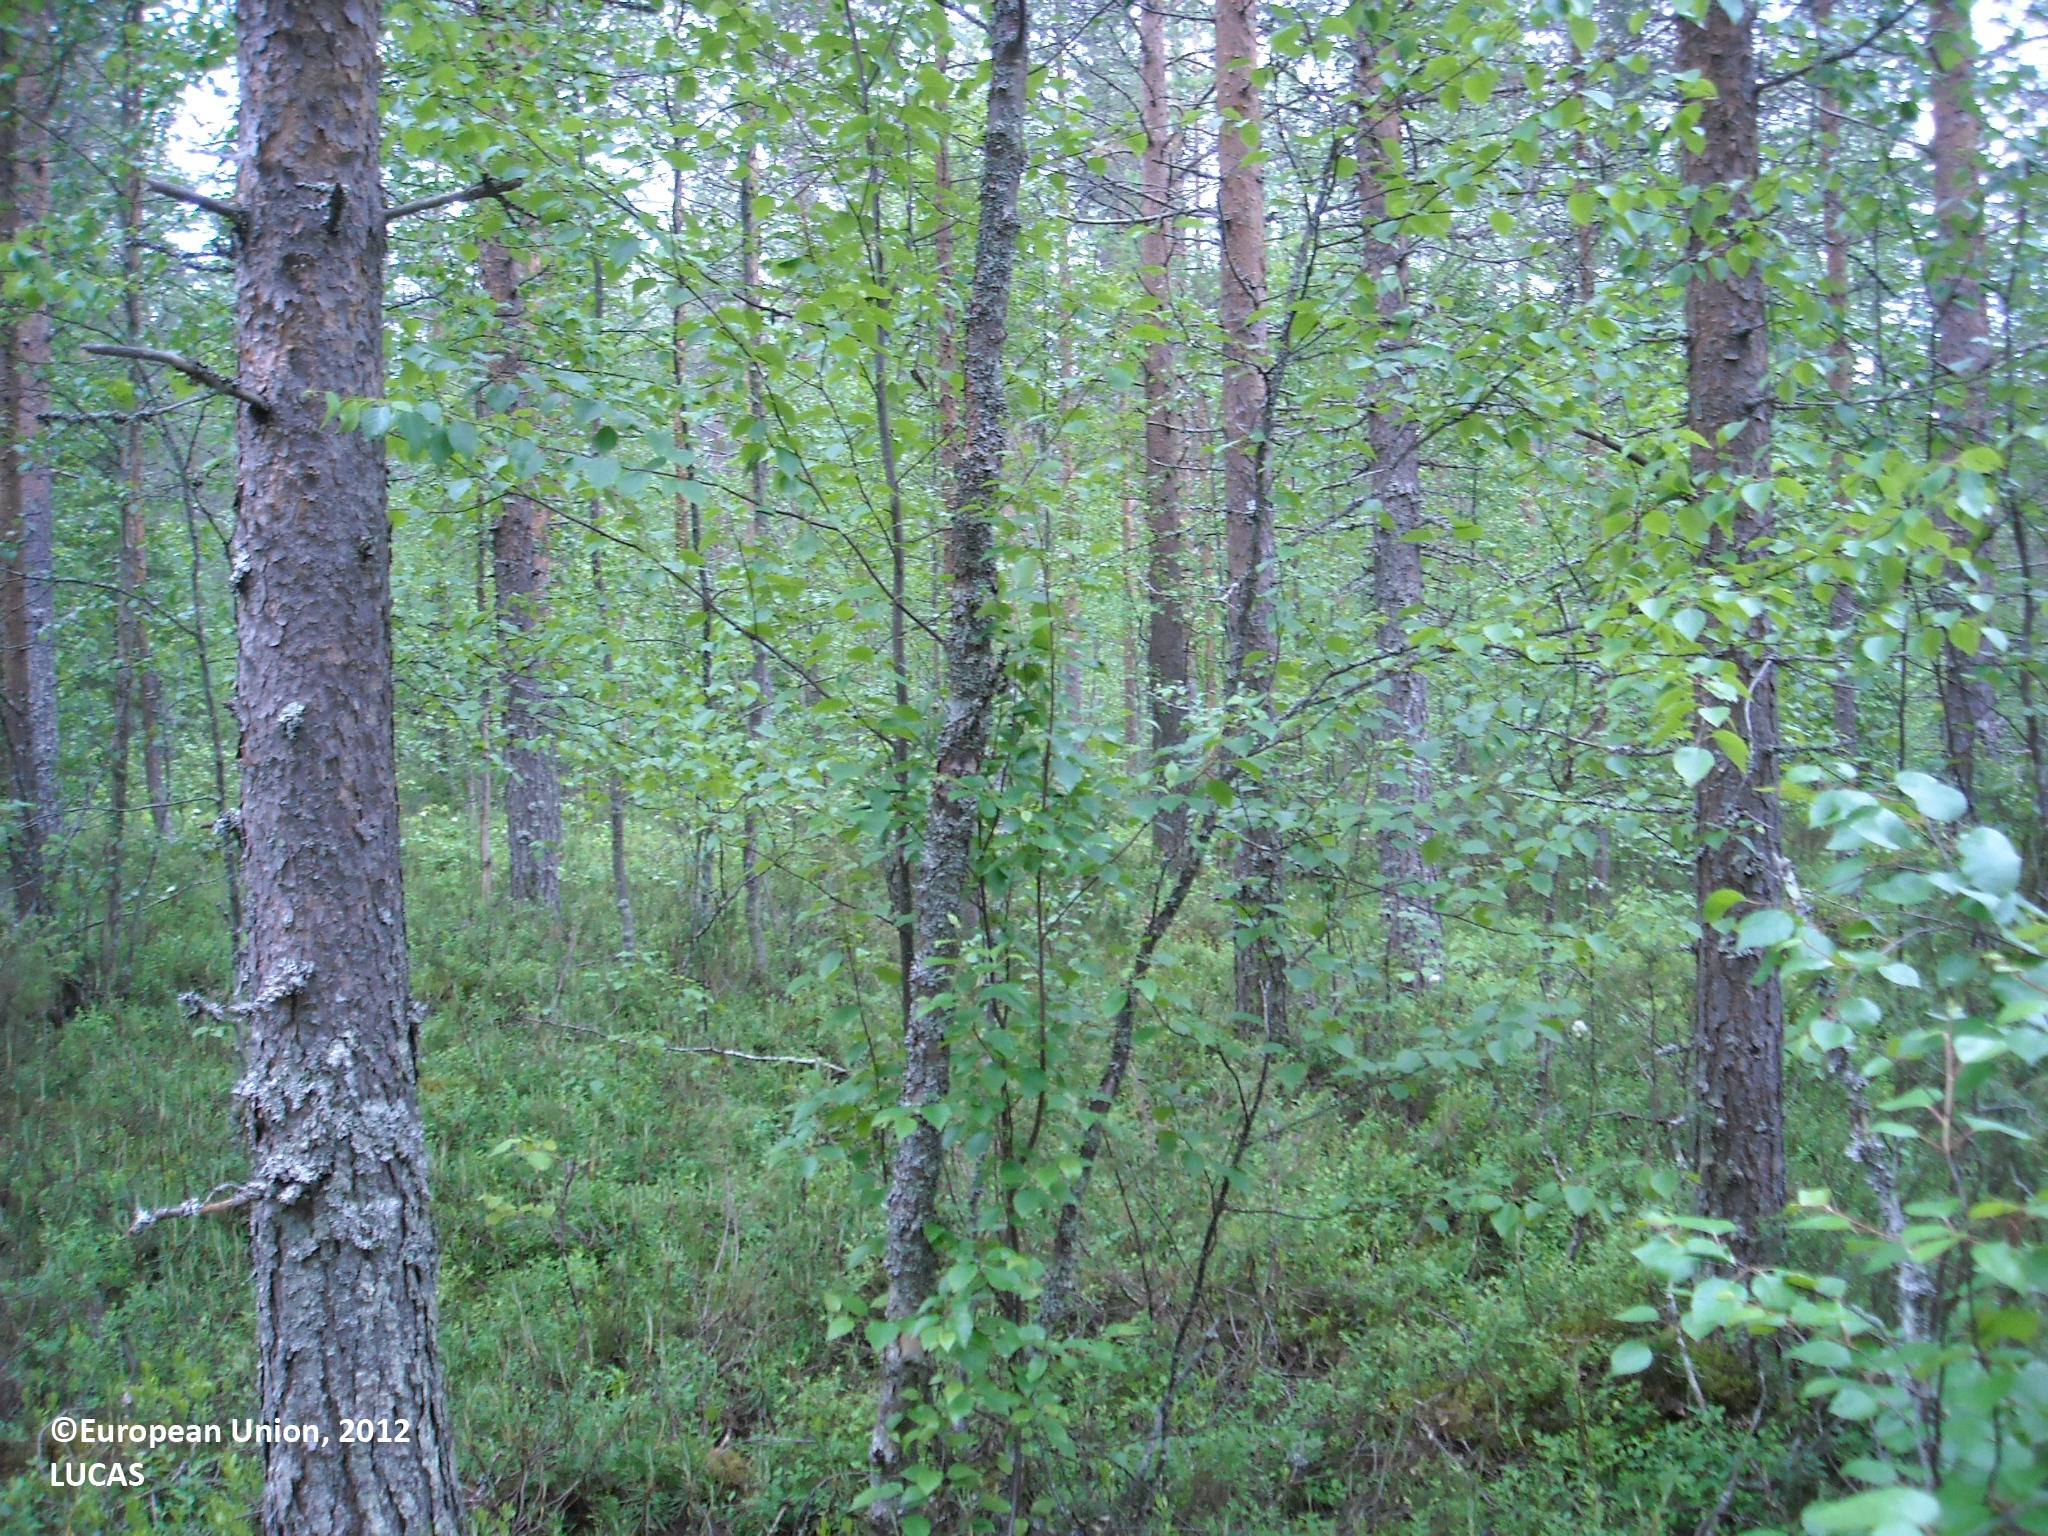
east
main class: Woodland
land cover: Pine dominated mixed woodland
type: boreal forest
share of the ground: > 75 %
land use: Forestry
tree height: > 5 m
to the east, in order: Pine dominated mixed woodland; Ditches and canals; Pine dominated mixed woodland; Ditches and canals; Pine dominated mixed woodland
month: June
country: FI
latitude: 64.8087
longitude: 27.3370
